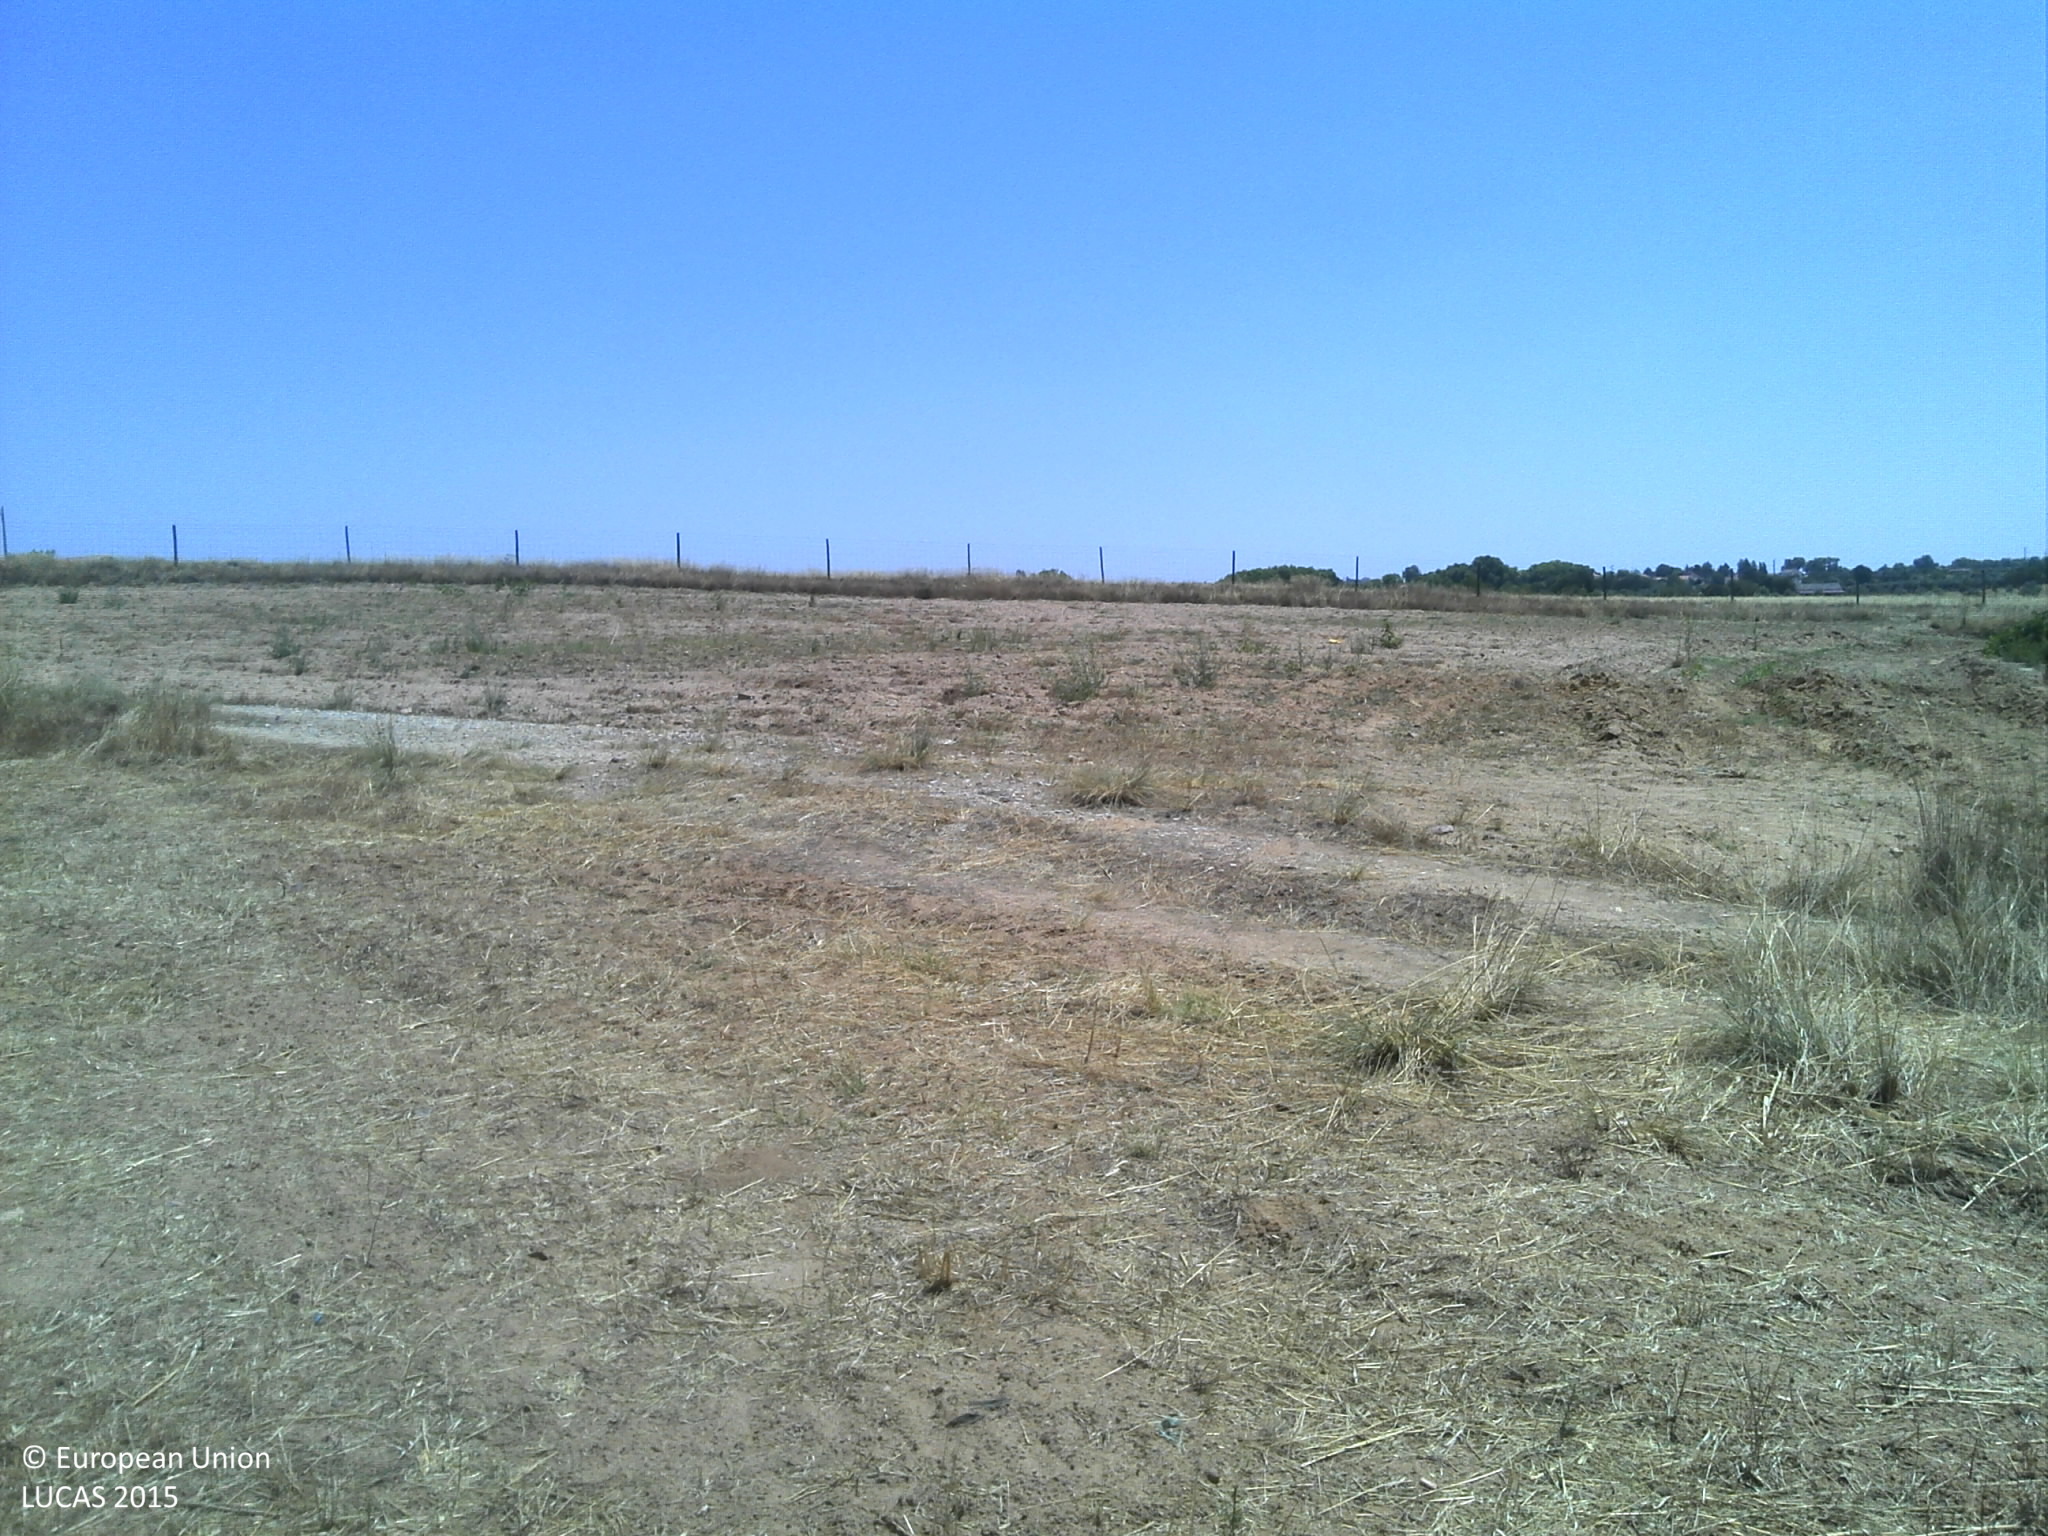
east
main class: Grassland
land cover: Grassland without tree/shrub cover
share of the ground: 10 - 25 %
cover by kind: unconsolidated bare surface 85 %, herbaceous plants 10 %
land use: Agriculture (excluding fallow land and kitchen gardens)
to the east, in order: Grassland without tree/shrub cover; Tracks; Spontaneously vegetated surfaces; Tracks; Fences; Grassland without tree/shrub cover; Olive groves; Fences; Grassland without tree/shrub cover; Olive groves; Grassland without tree/shrub cover
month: June
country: PT
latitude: 39.8453
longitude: -7.2860
